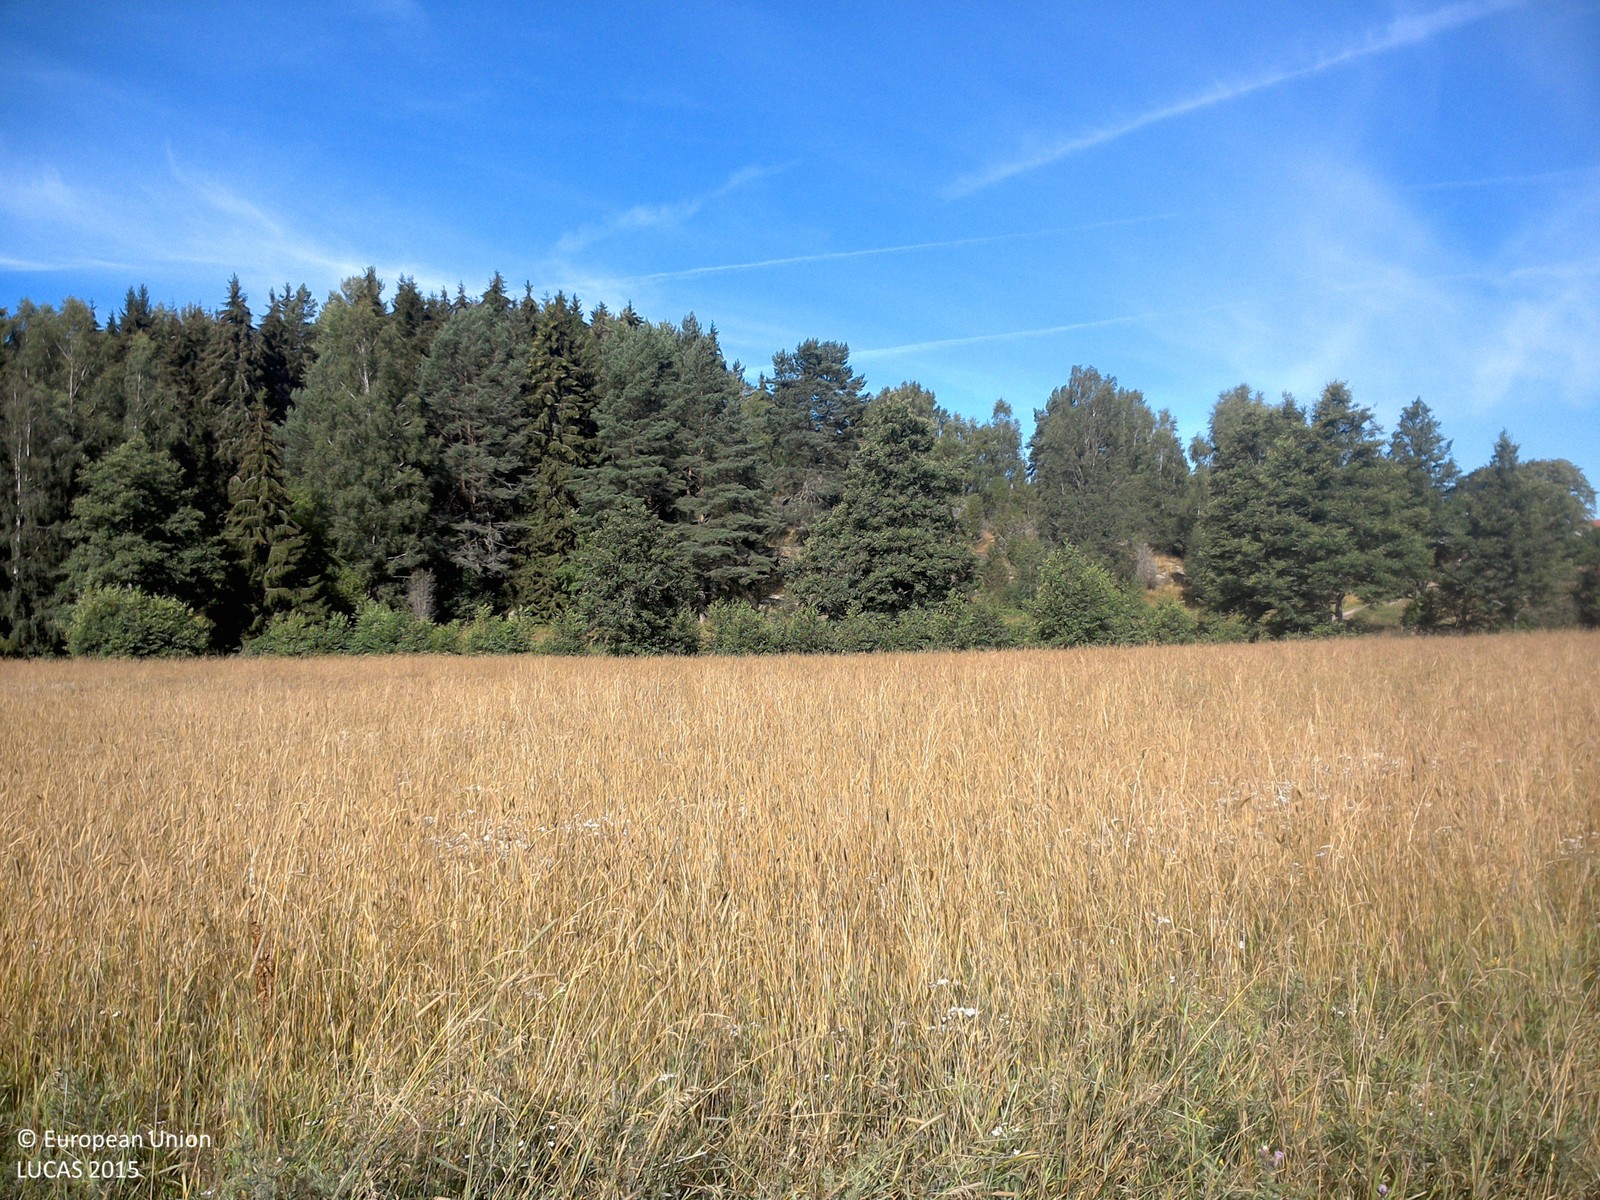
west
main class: Cropland
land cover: Other leguminous and mixtures for fodder
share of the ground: > 75 %
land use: Agriculture (excluding fallow land and kitchen gardens)
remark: Harvested field
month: August
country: SE
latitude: 58.2545
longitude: 14.9530
